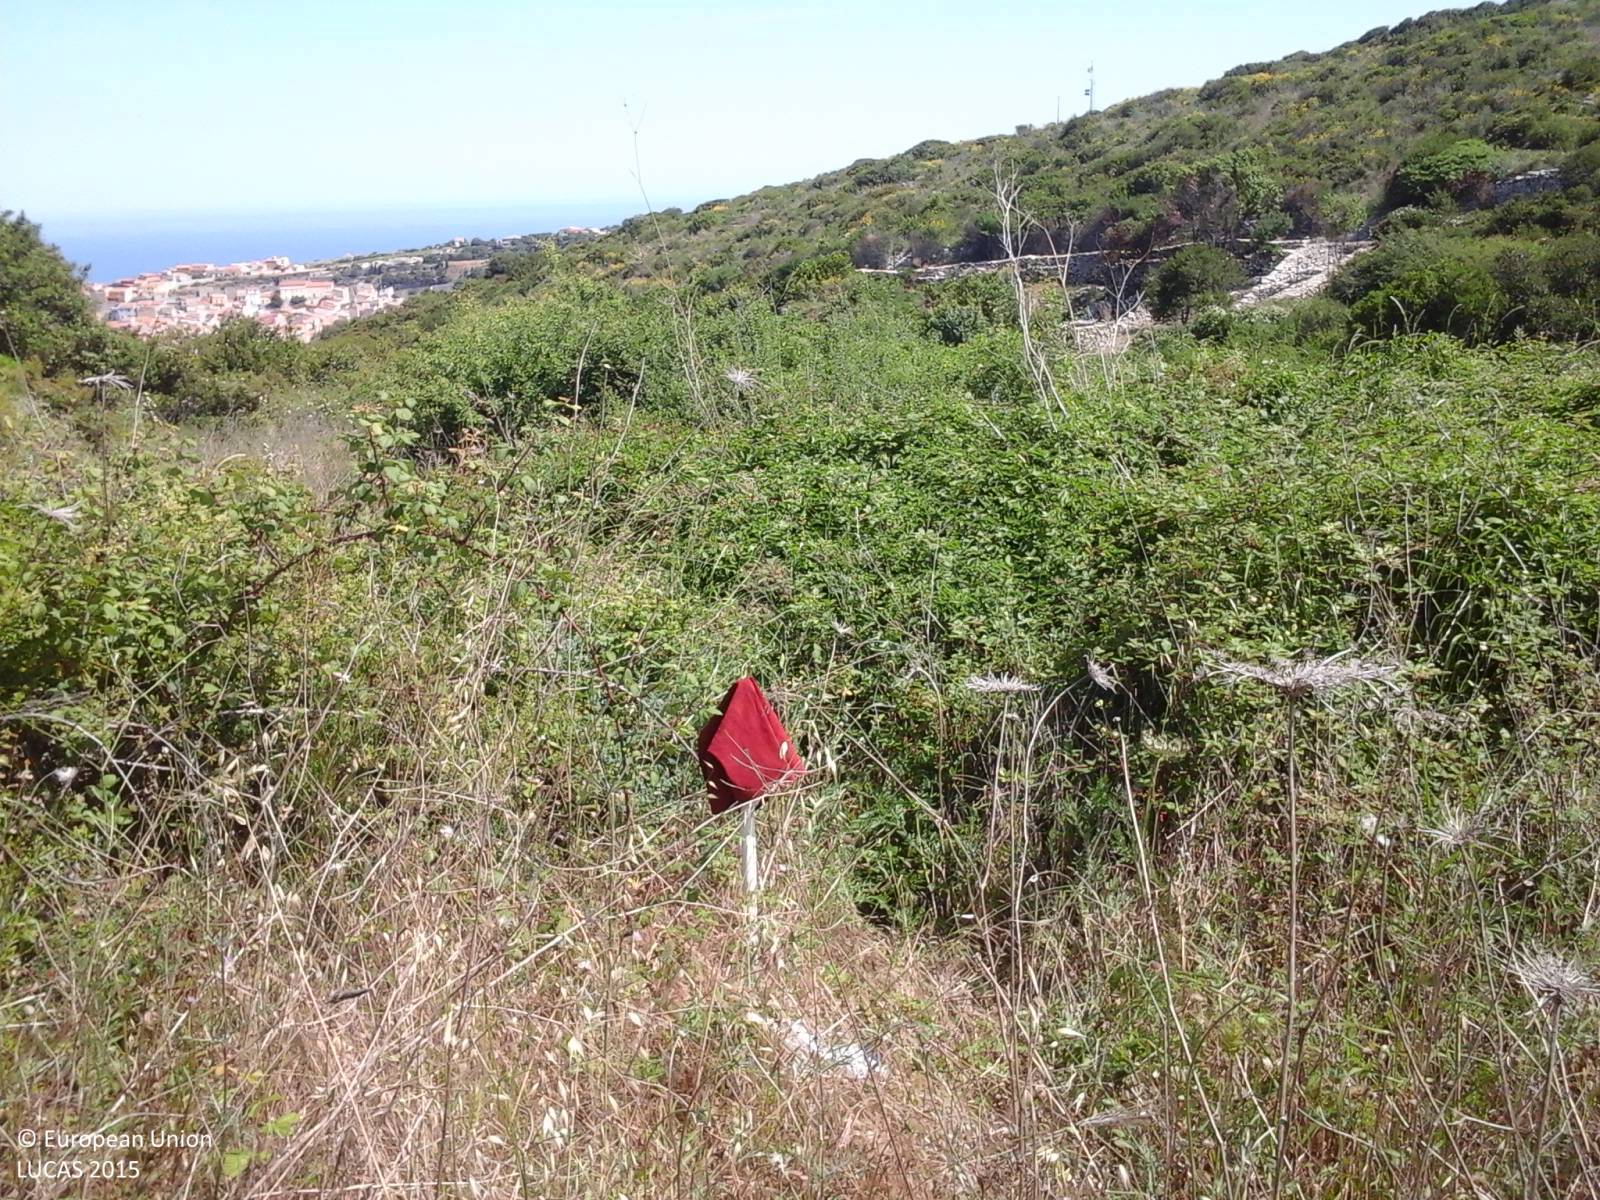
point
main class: Shrubland
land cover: Shrubland without tree cover
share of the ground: > 75 %
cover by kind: herbaceous plants 55 %, shrubs 45 %
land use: Semi-natural and natural areas not in use
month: May
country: IT
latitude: 40.7822
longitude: 8.5966
